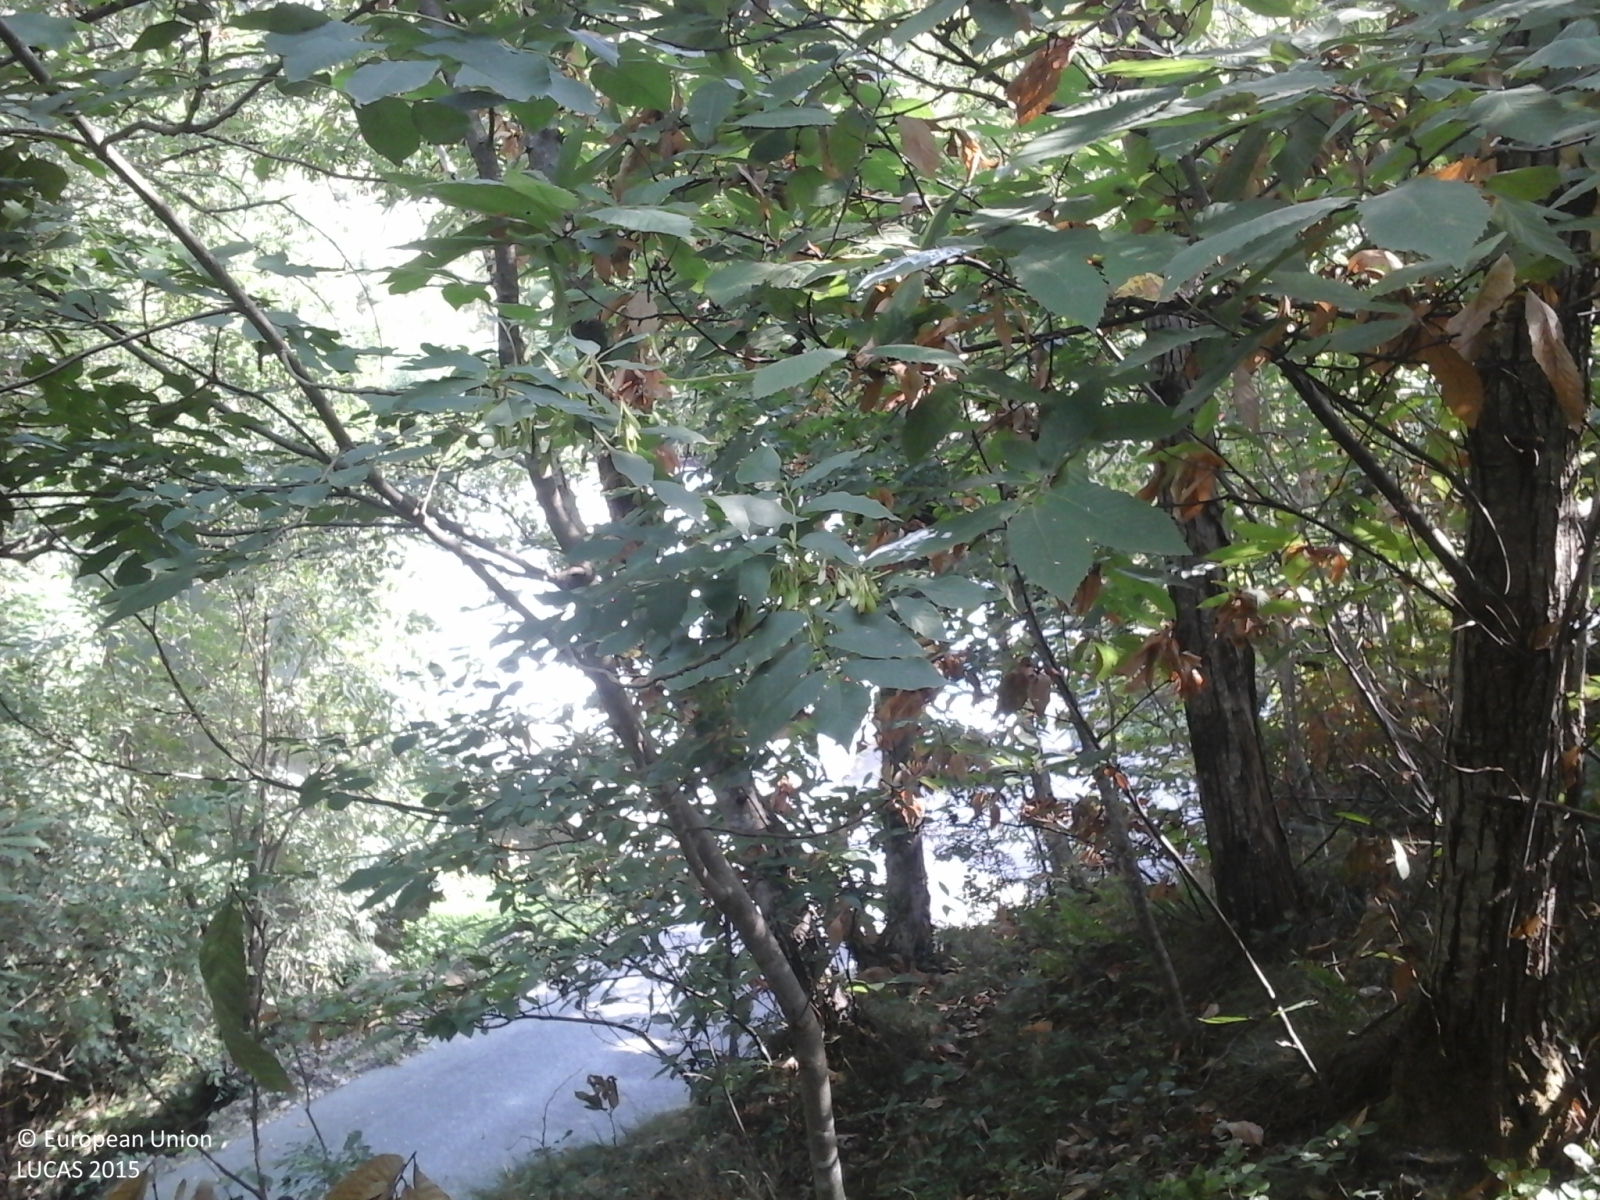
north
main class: Woodland
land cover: Broadleaved woodland
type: mesophytic deciduous forest
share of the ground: > 75 %
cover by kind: broadleaved forest trees 100 %
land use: Forestry
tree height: > 5 m
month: September
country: IT
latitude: 44.4552
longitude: 9.1348
